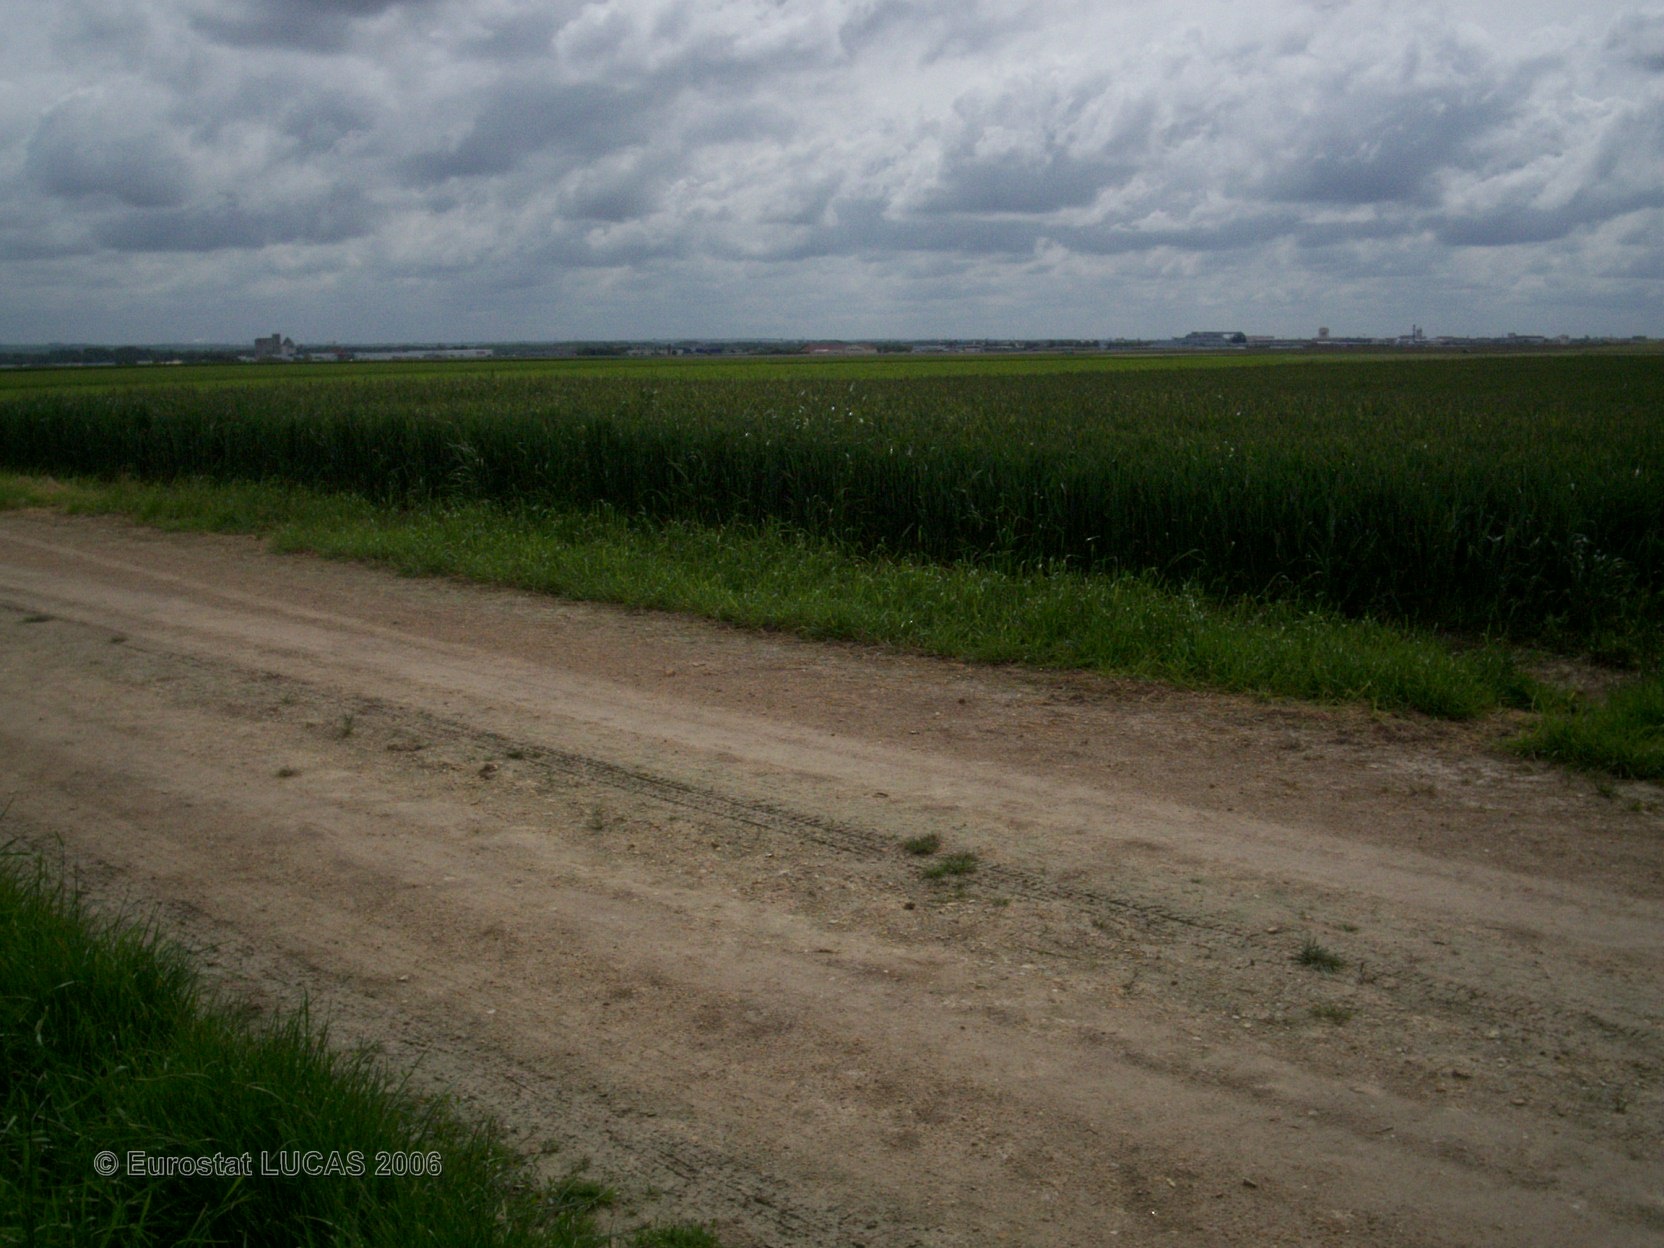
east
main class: Cropland
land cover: Rape and turnip rape
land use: Agriculture (excluding fallow land and kitchen gardens)
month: April
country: FR
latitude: 48.3304
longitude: 3.9935
